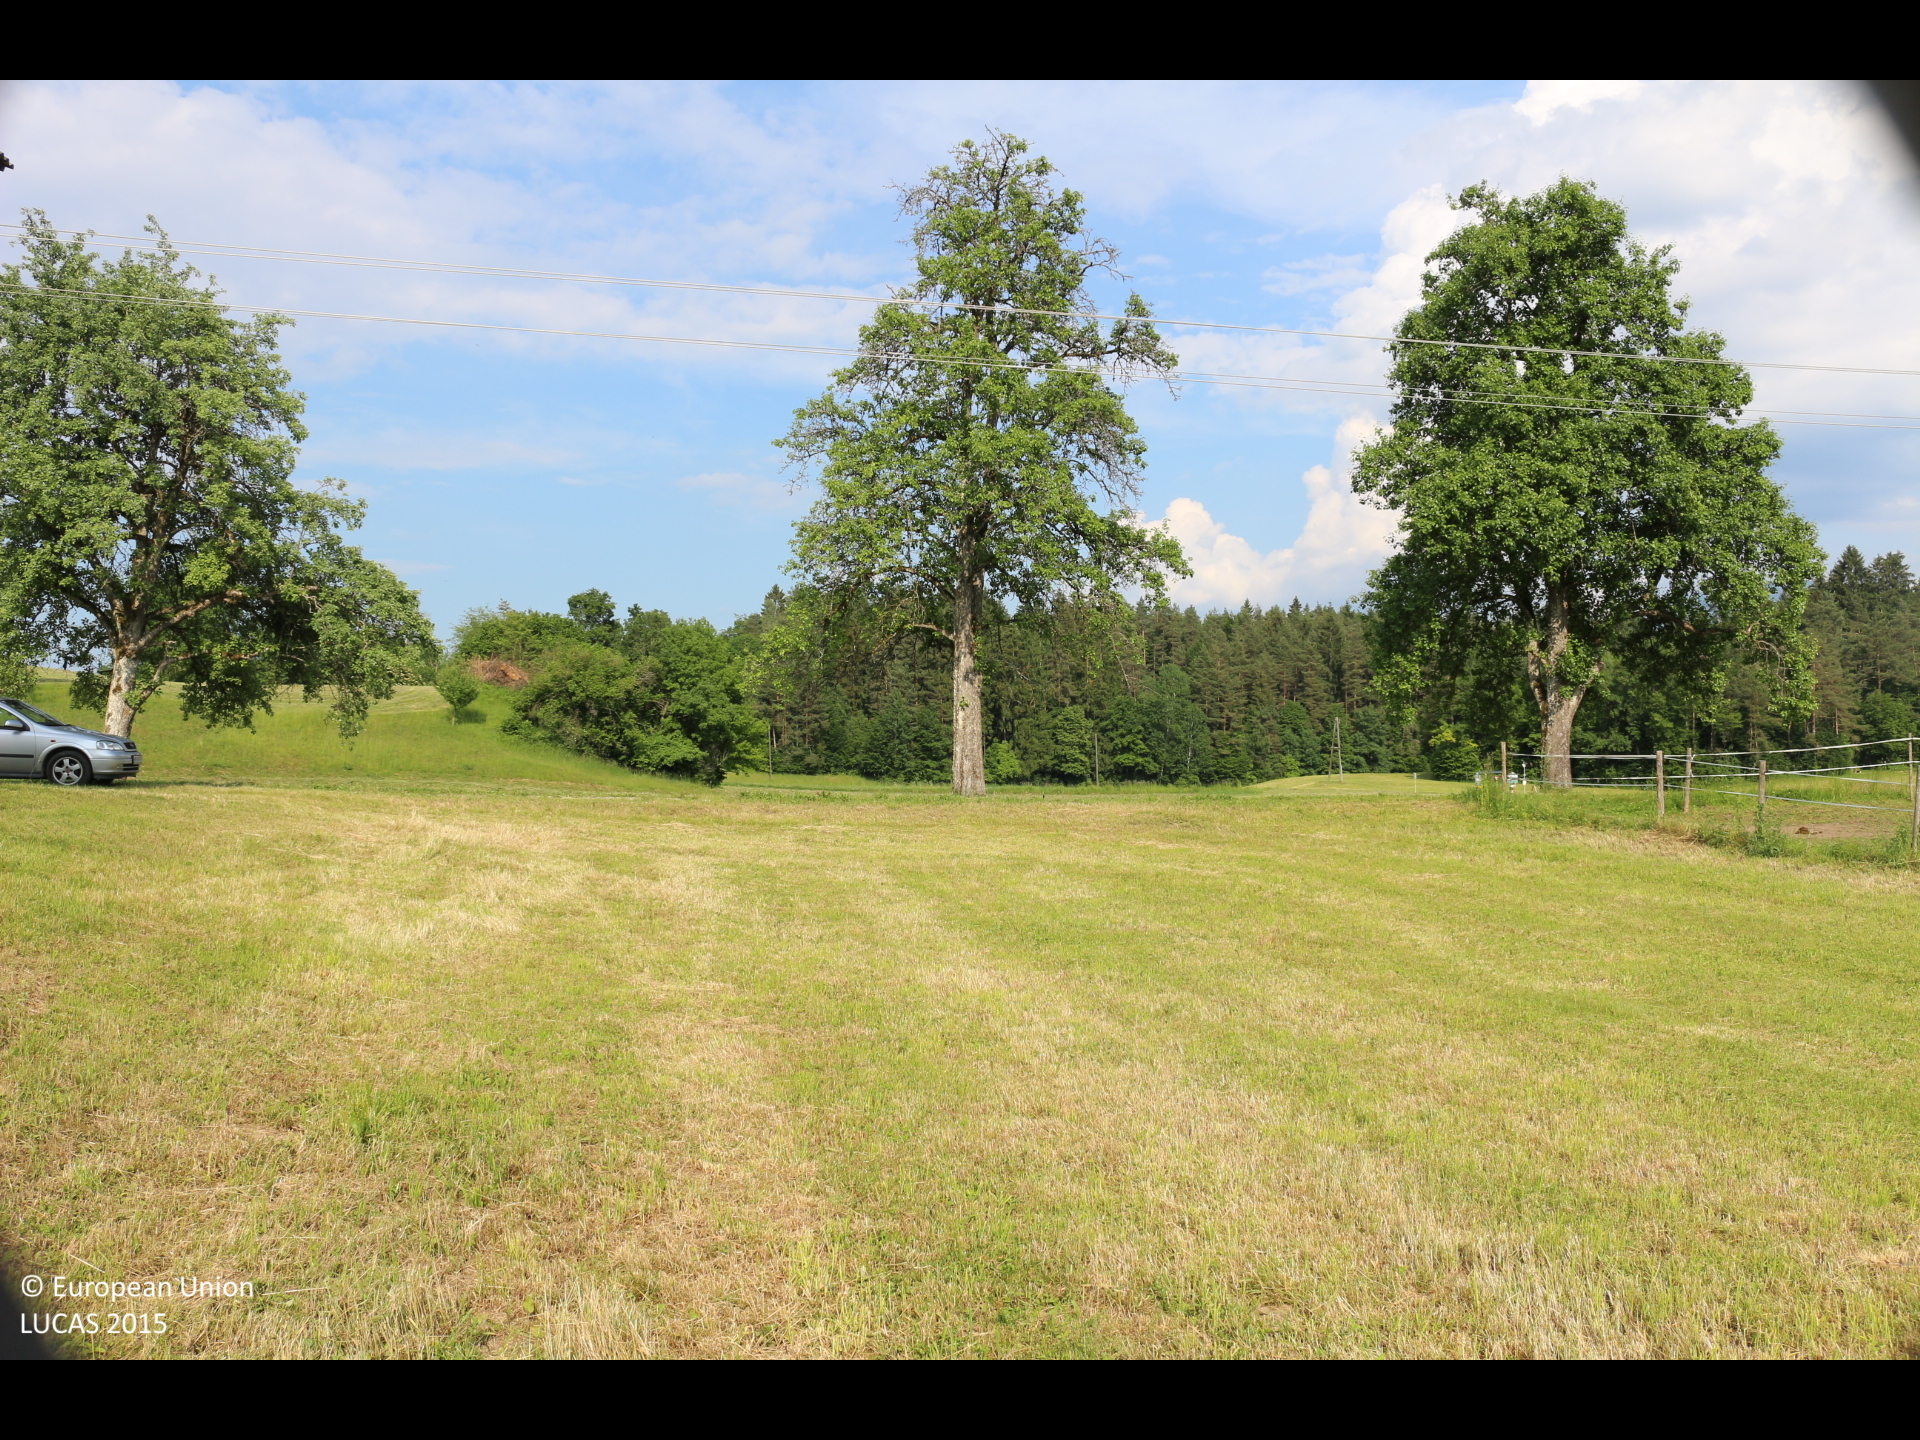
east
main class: Grassland
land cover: Grassland without tree/shrub cover
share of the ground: > 75 %
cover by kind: herbaceous plants 100 %
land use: Agriculture (excluding fallow land and kitchen gardens)
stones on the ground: < 10 %
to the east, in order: Grassland without tree/shrub cover; Electric lines; Grassland without tree/shrub cover; Tracks; Lines of trees; Grassland without tree/shrub cover; Paved roads, cycling and walking lanes; Grassland without tree/shrub cover; Potatoes; Rye; Maize; Grass margins; Paved roads, cycling and walking lanes; Oats
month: June
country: AT
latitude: 46.5549
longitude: 14.2625
